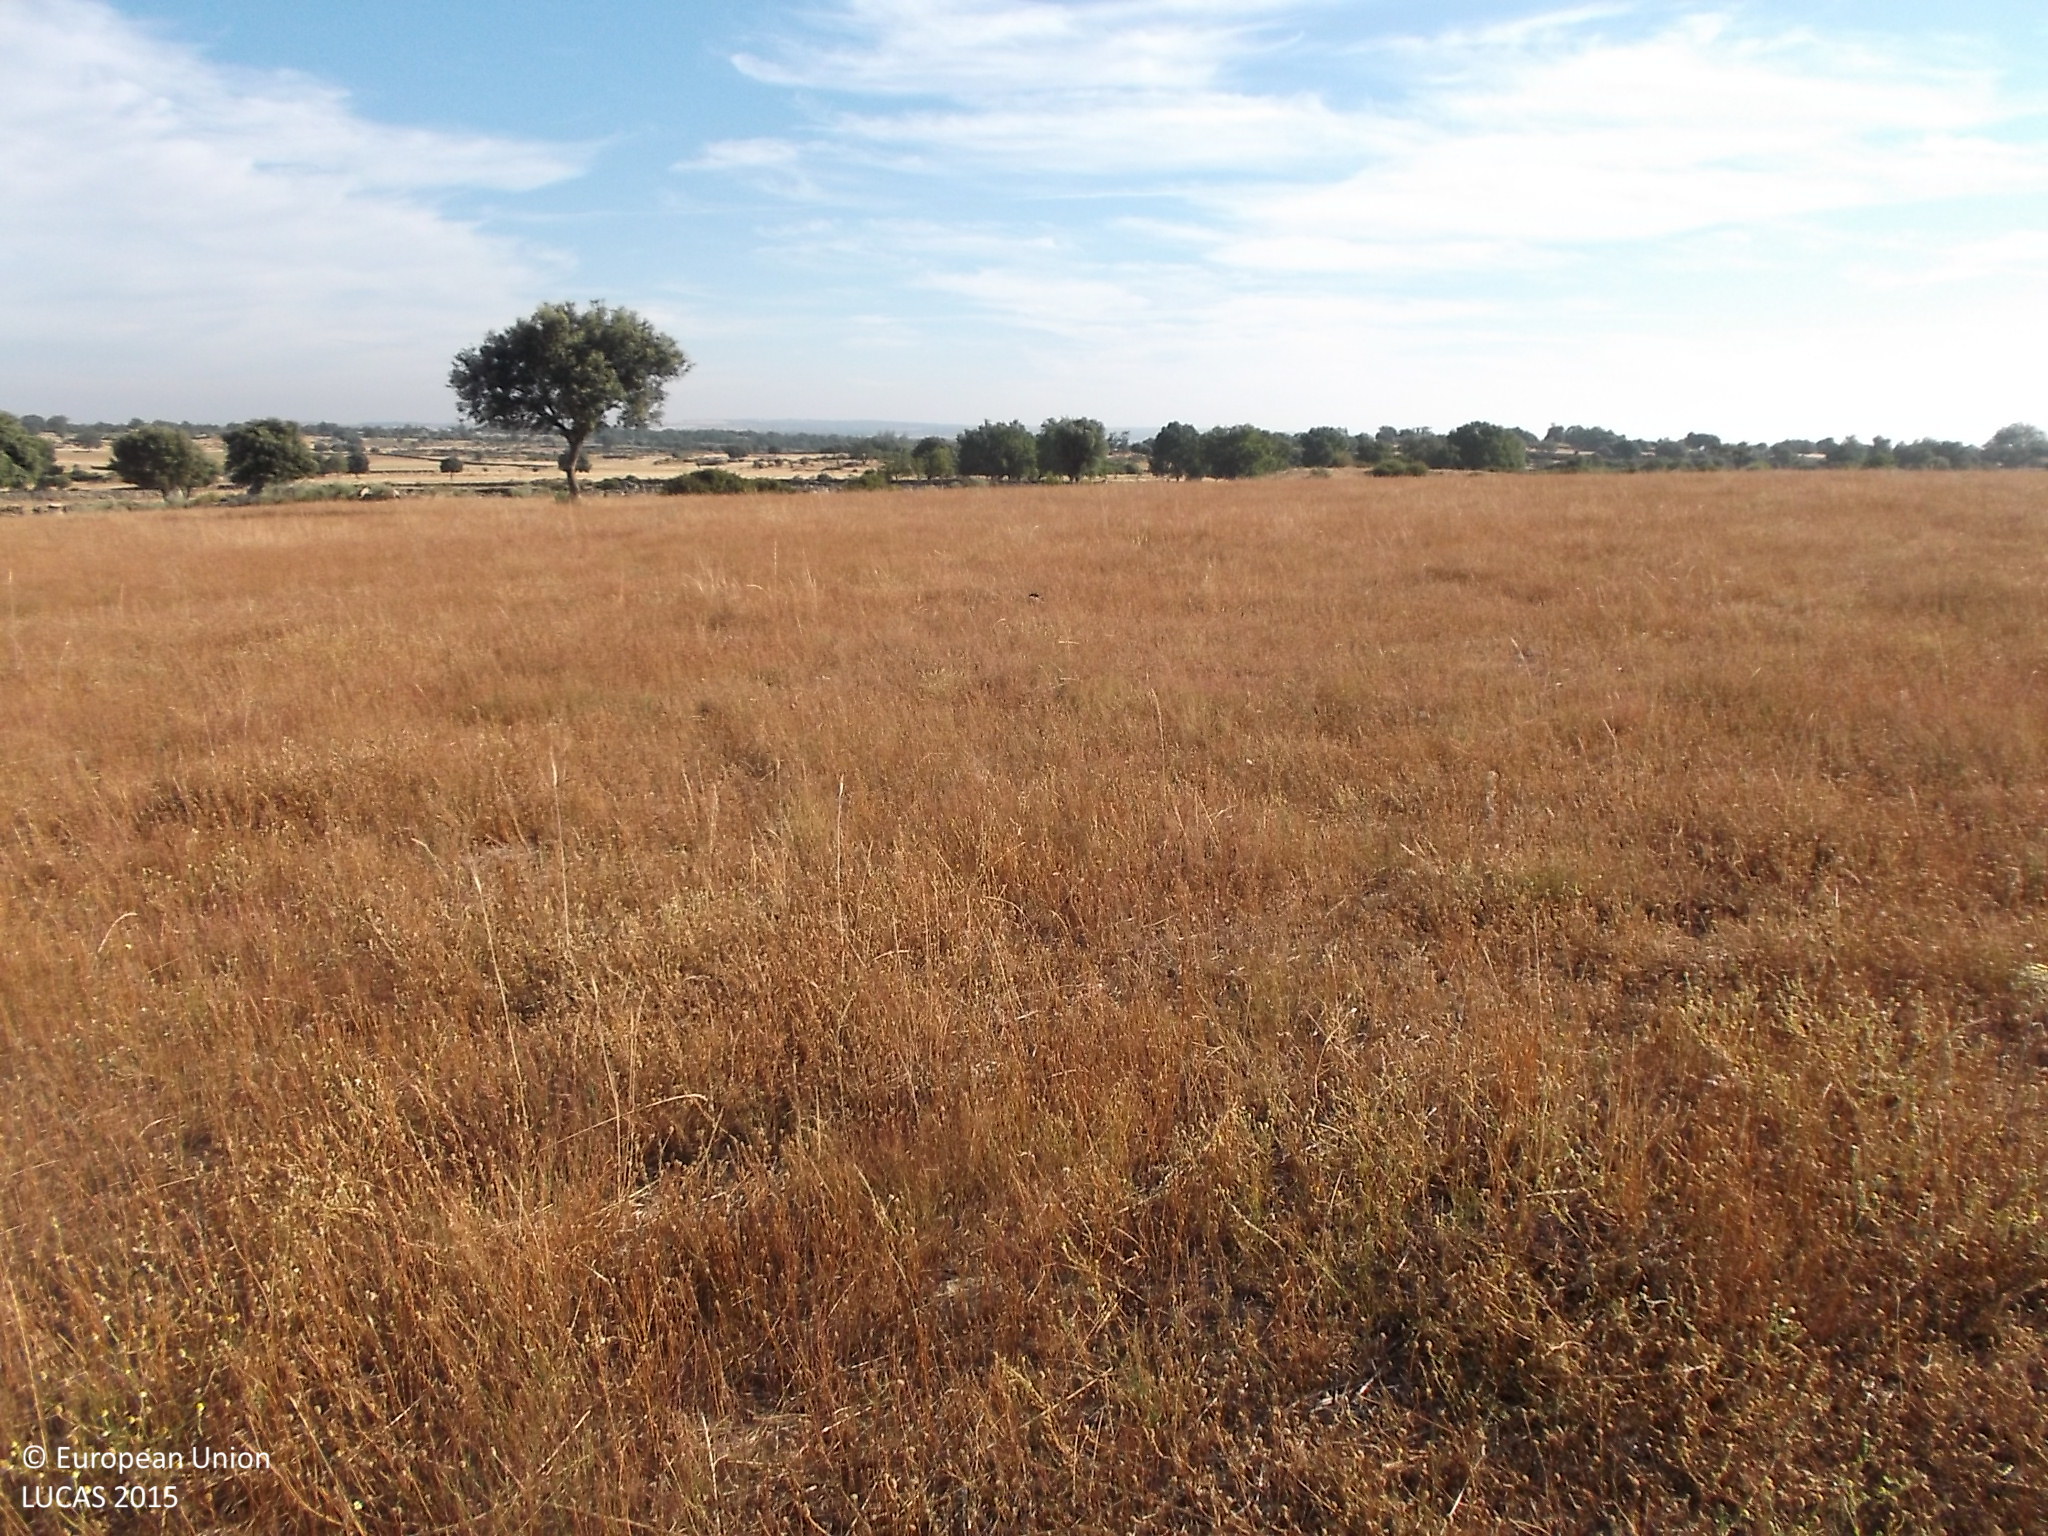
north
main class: Grassland
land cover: Grassland without tree/shrub cover
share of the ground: > 75 %
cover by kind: herbaceous plants 100 %
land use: Agriculture (excluding fallow land and kitchen gardens)
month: July
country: ES
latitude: 41.2261
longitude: -6.3308
